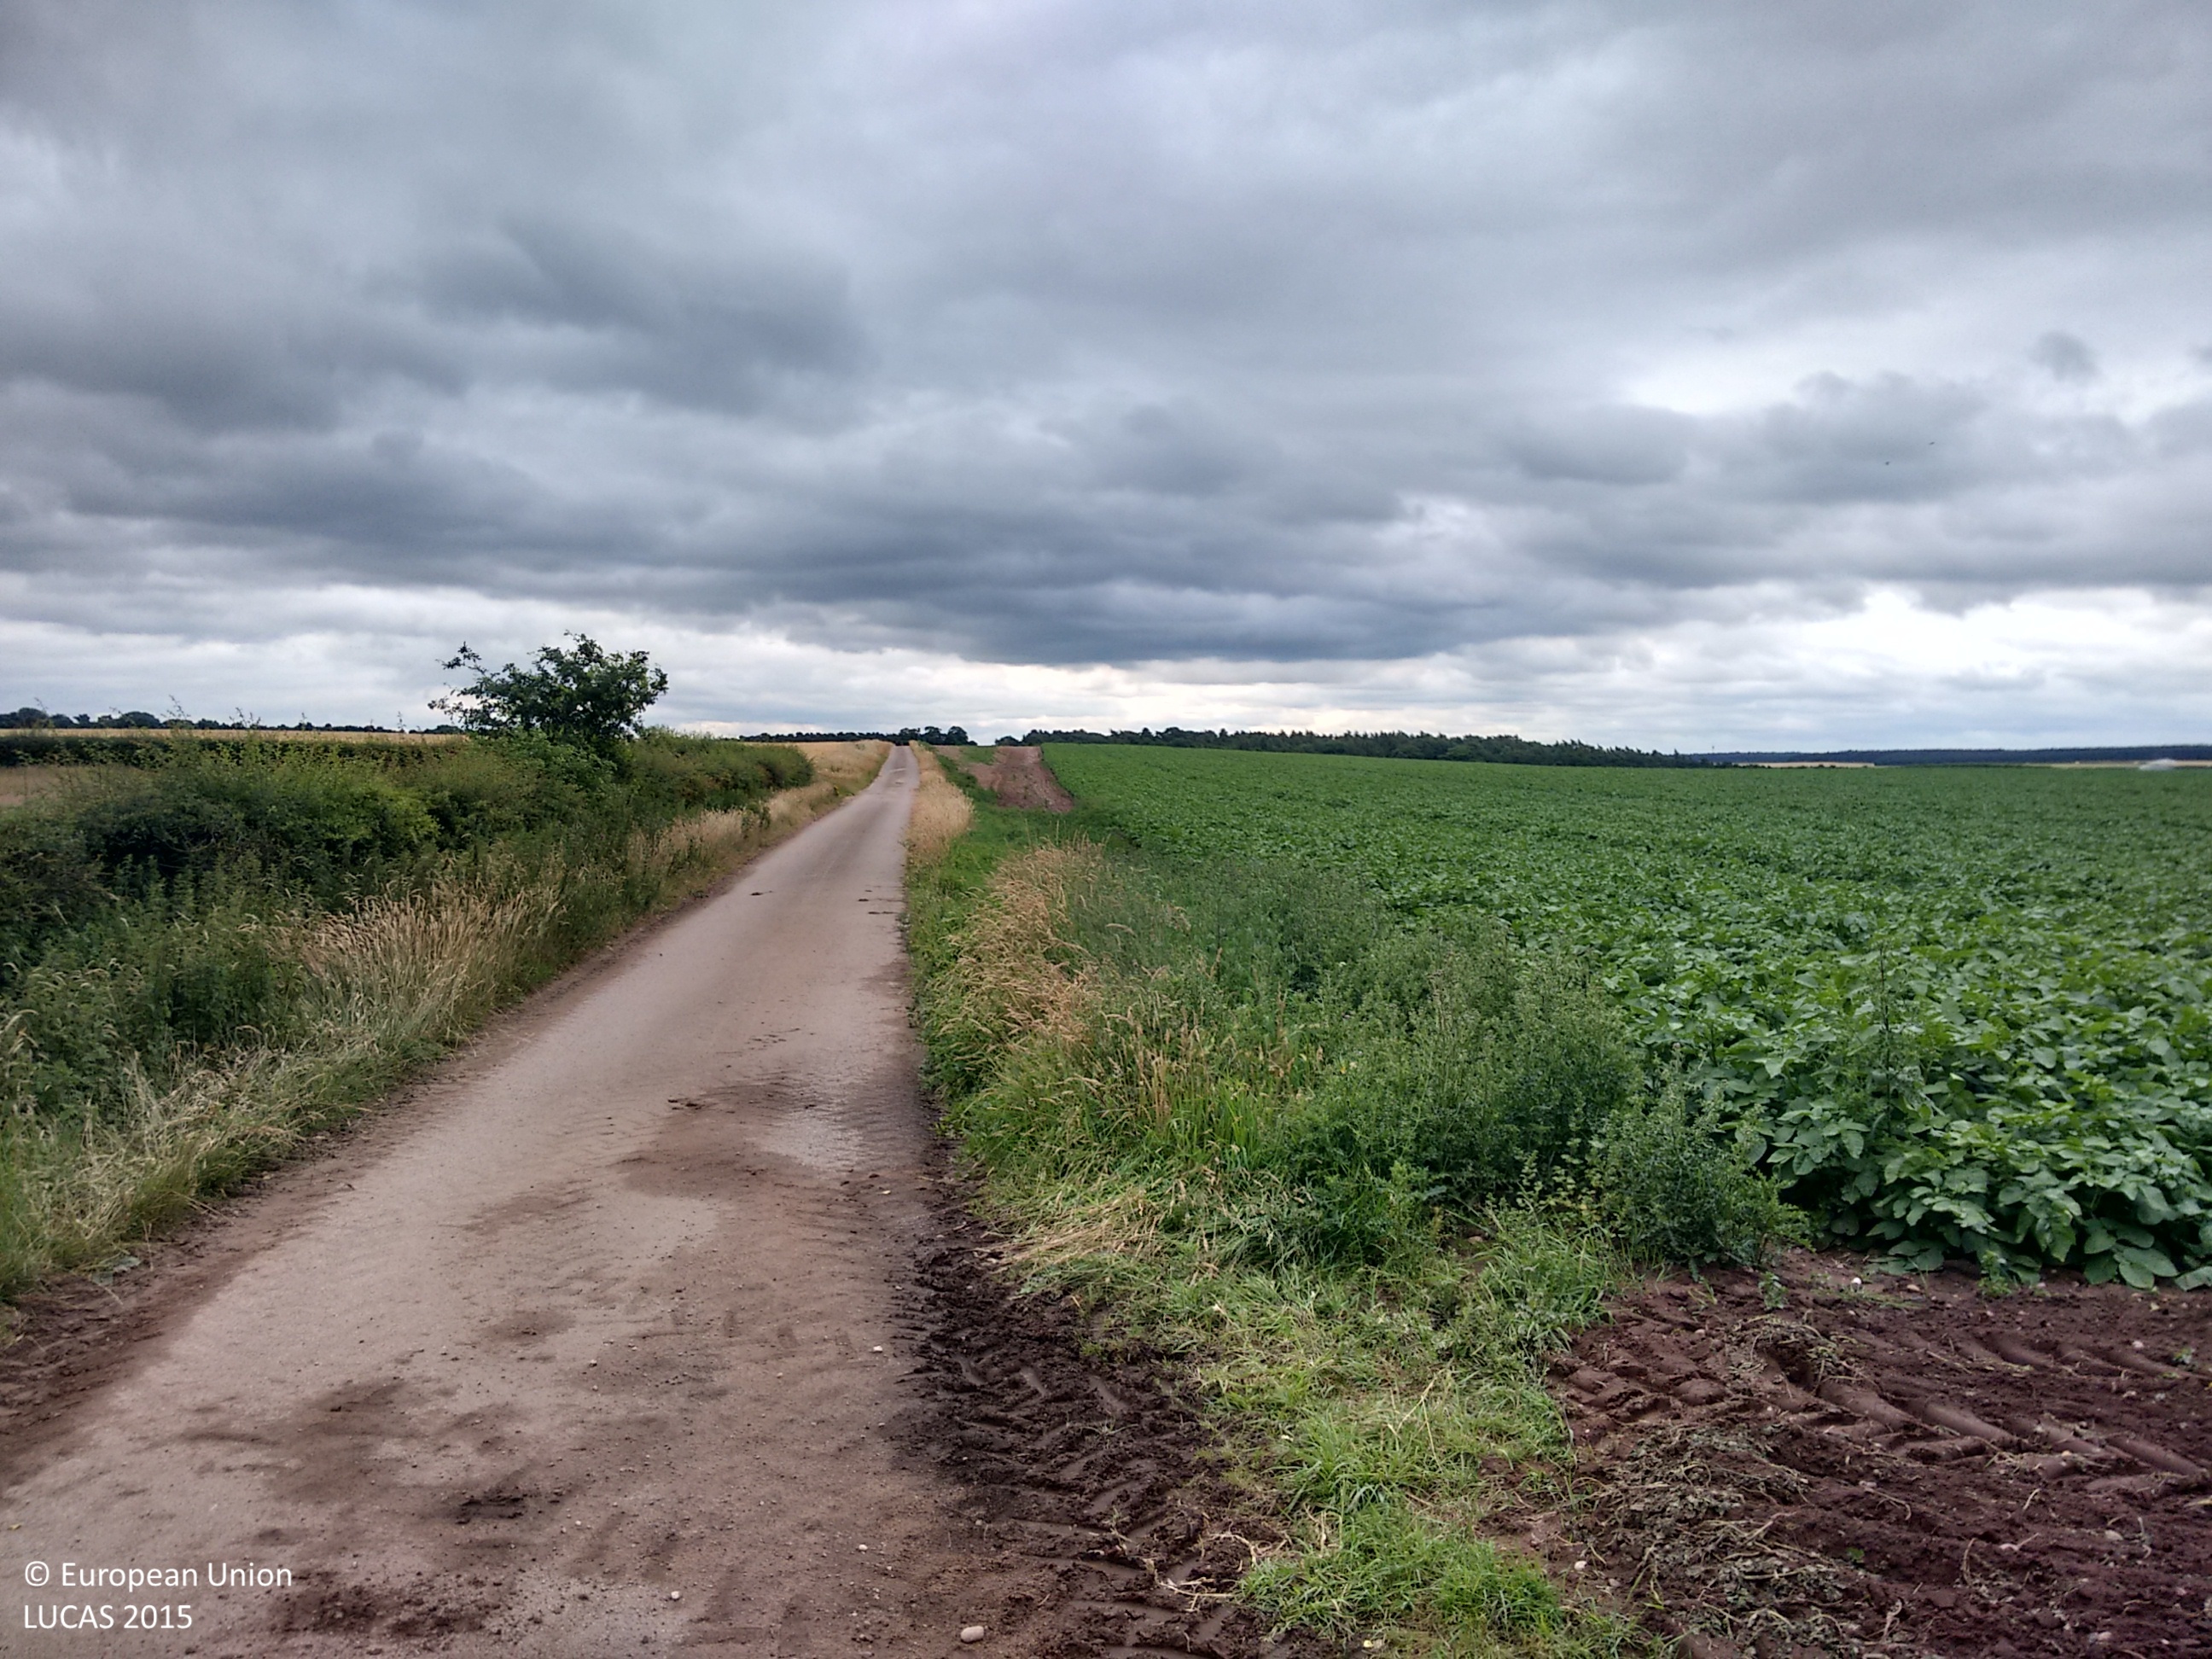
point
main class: Cropland
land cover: Potatoes
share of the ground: > 75 %
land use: Agriculture (excluding fallow land and kitchen gardens)
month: July
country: GB
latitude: 53.3656
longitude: -1.0598
